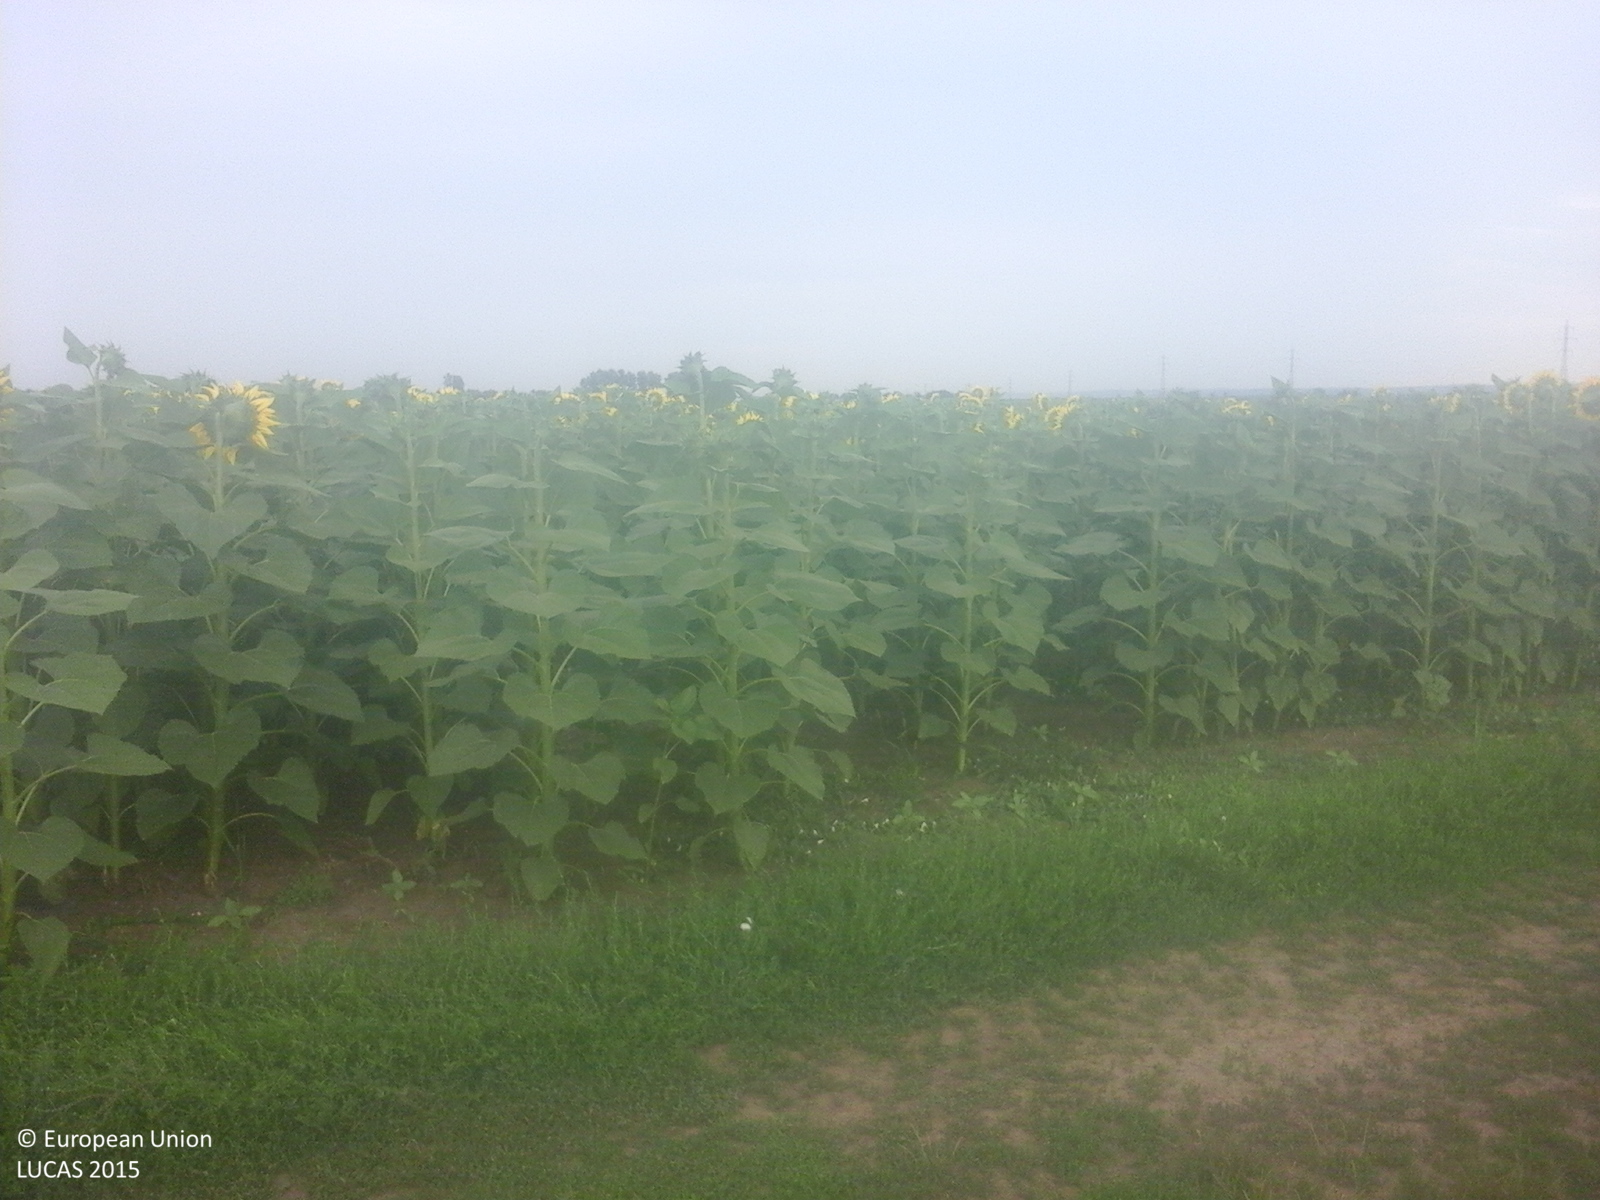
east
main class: Cropland
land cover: Sunflower
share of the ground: > 75 %
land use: Agriculture (excluding fallow land and kitchen gardens)
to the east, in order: Sunflower; Tracks; Sunflower
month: July
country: RO
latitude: 43.7848
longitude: 24.6176
